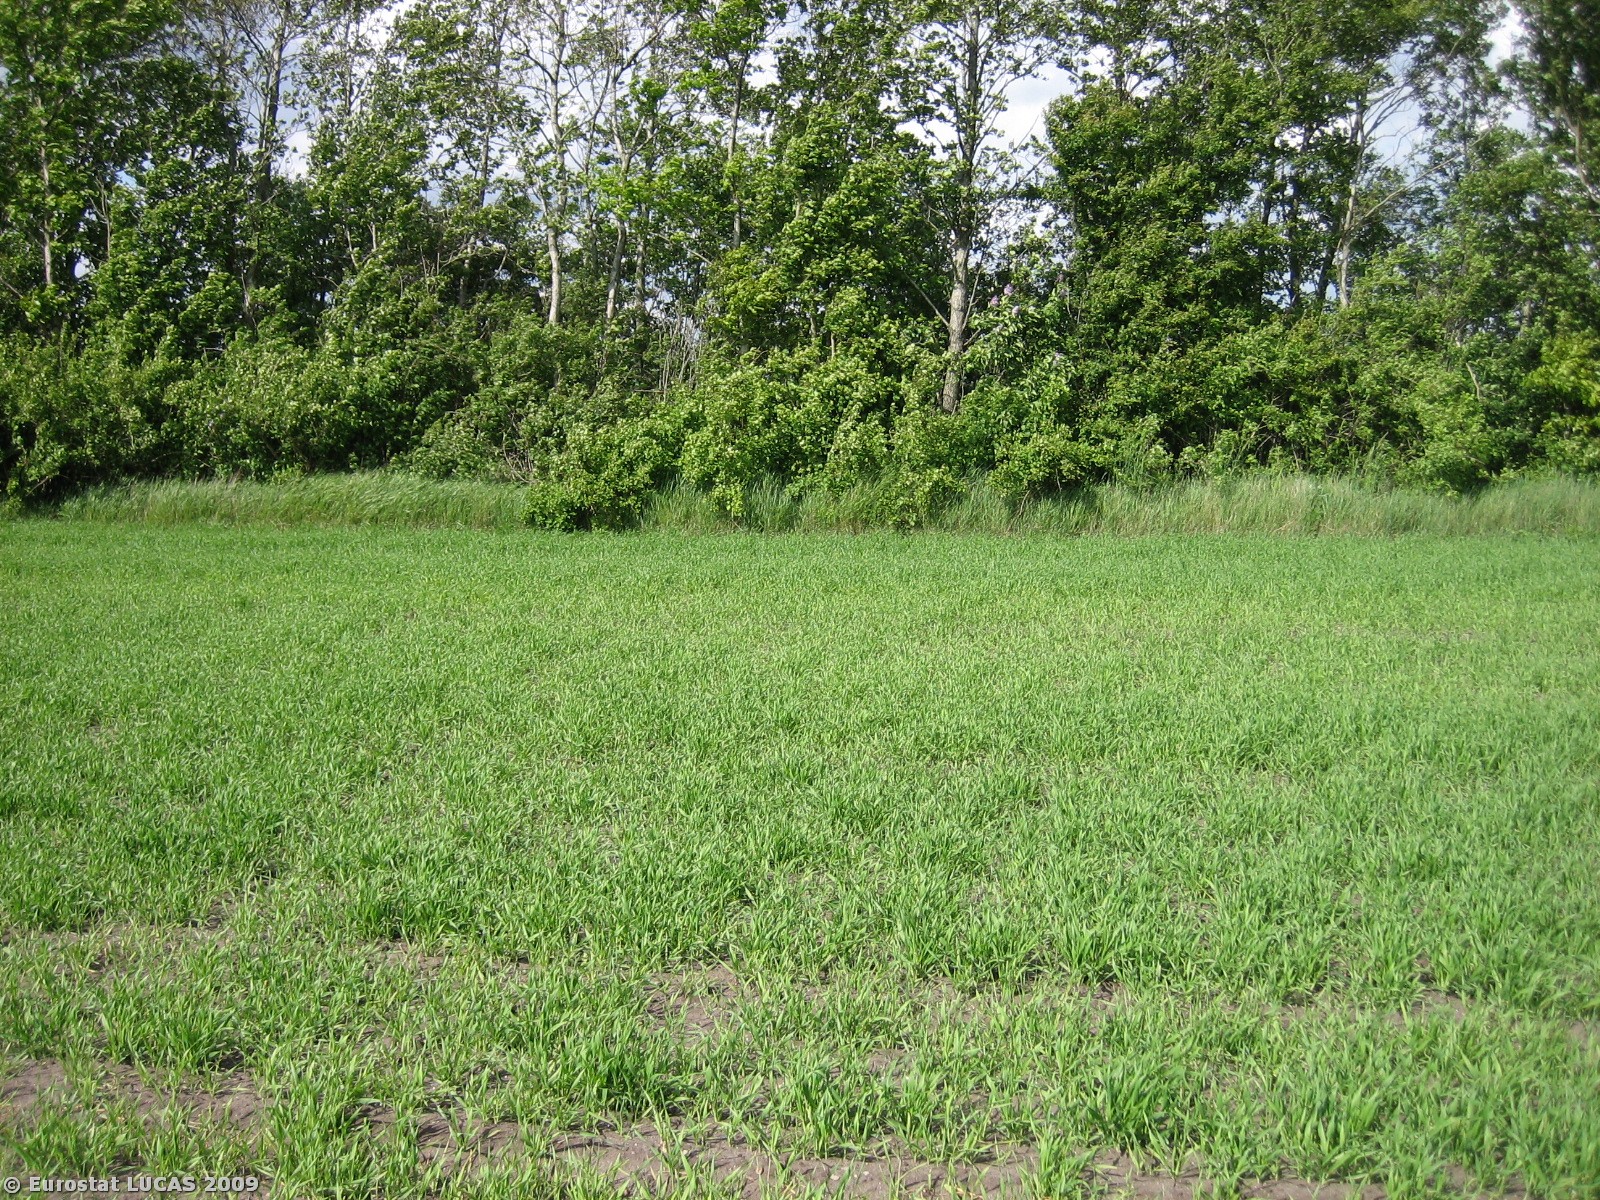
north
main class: Cropland
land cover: Barley
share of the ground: 50 - 75 %
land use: Agriculture (excluding fallow land and kitchen gardens)
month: May
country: DK
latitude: 56.2736
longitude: 8.9838
